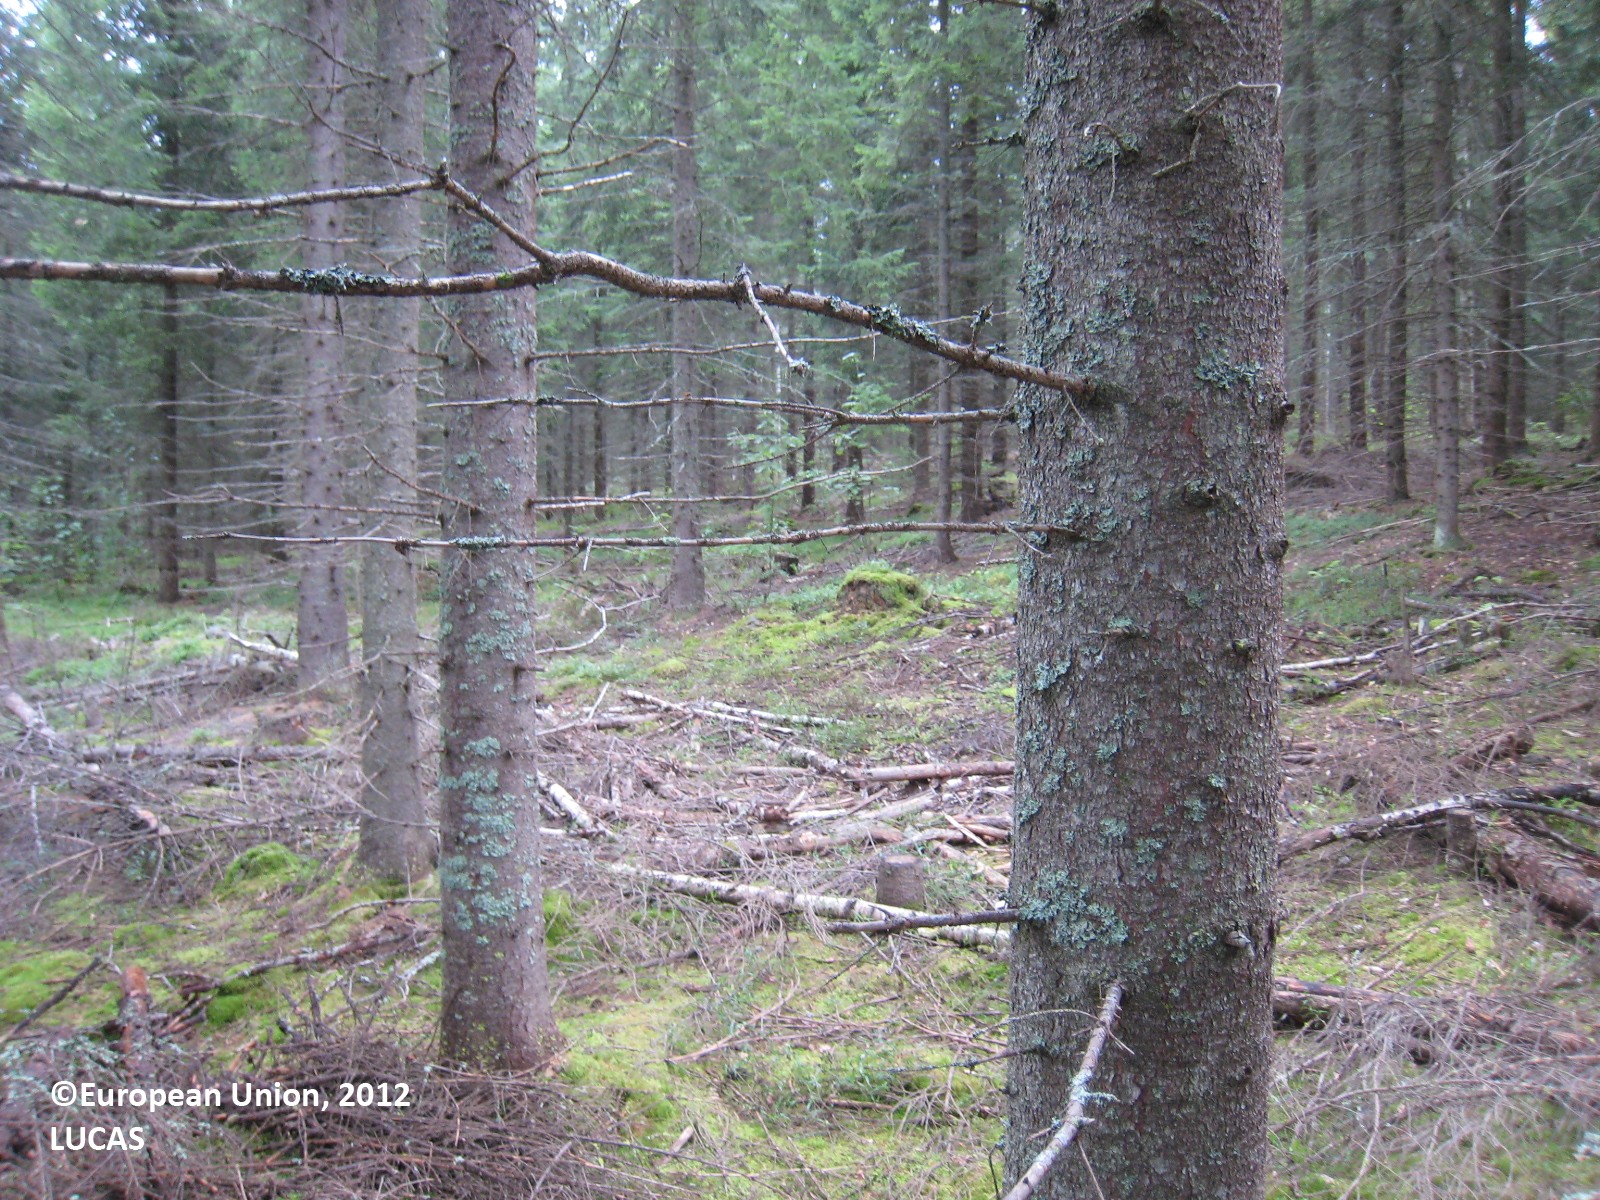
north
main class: Woodland
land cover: Spruce dominated coniferous woodland
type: boreal forest
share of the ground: 50 - 75 %
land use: Forestry
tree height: > 5 m
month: August
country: FI
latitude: 61.8292
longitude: 26.1020
